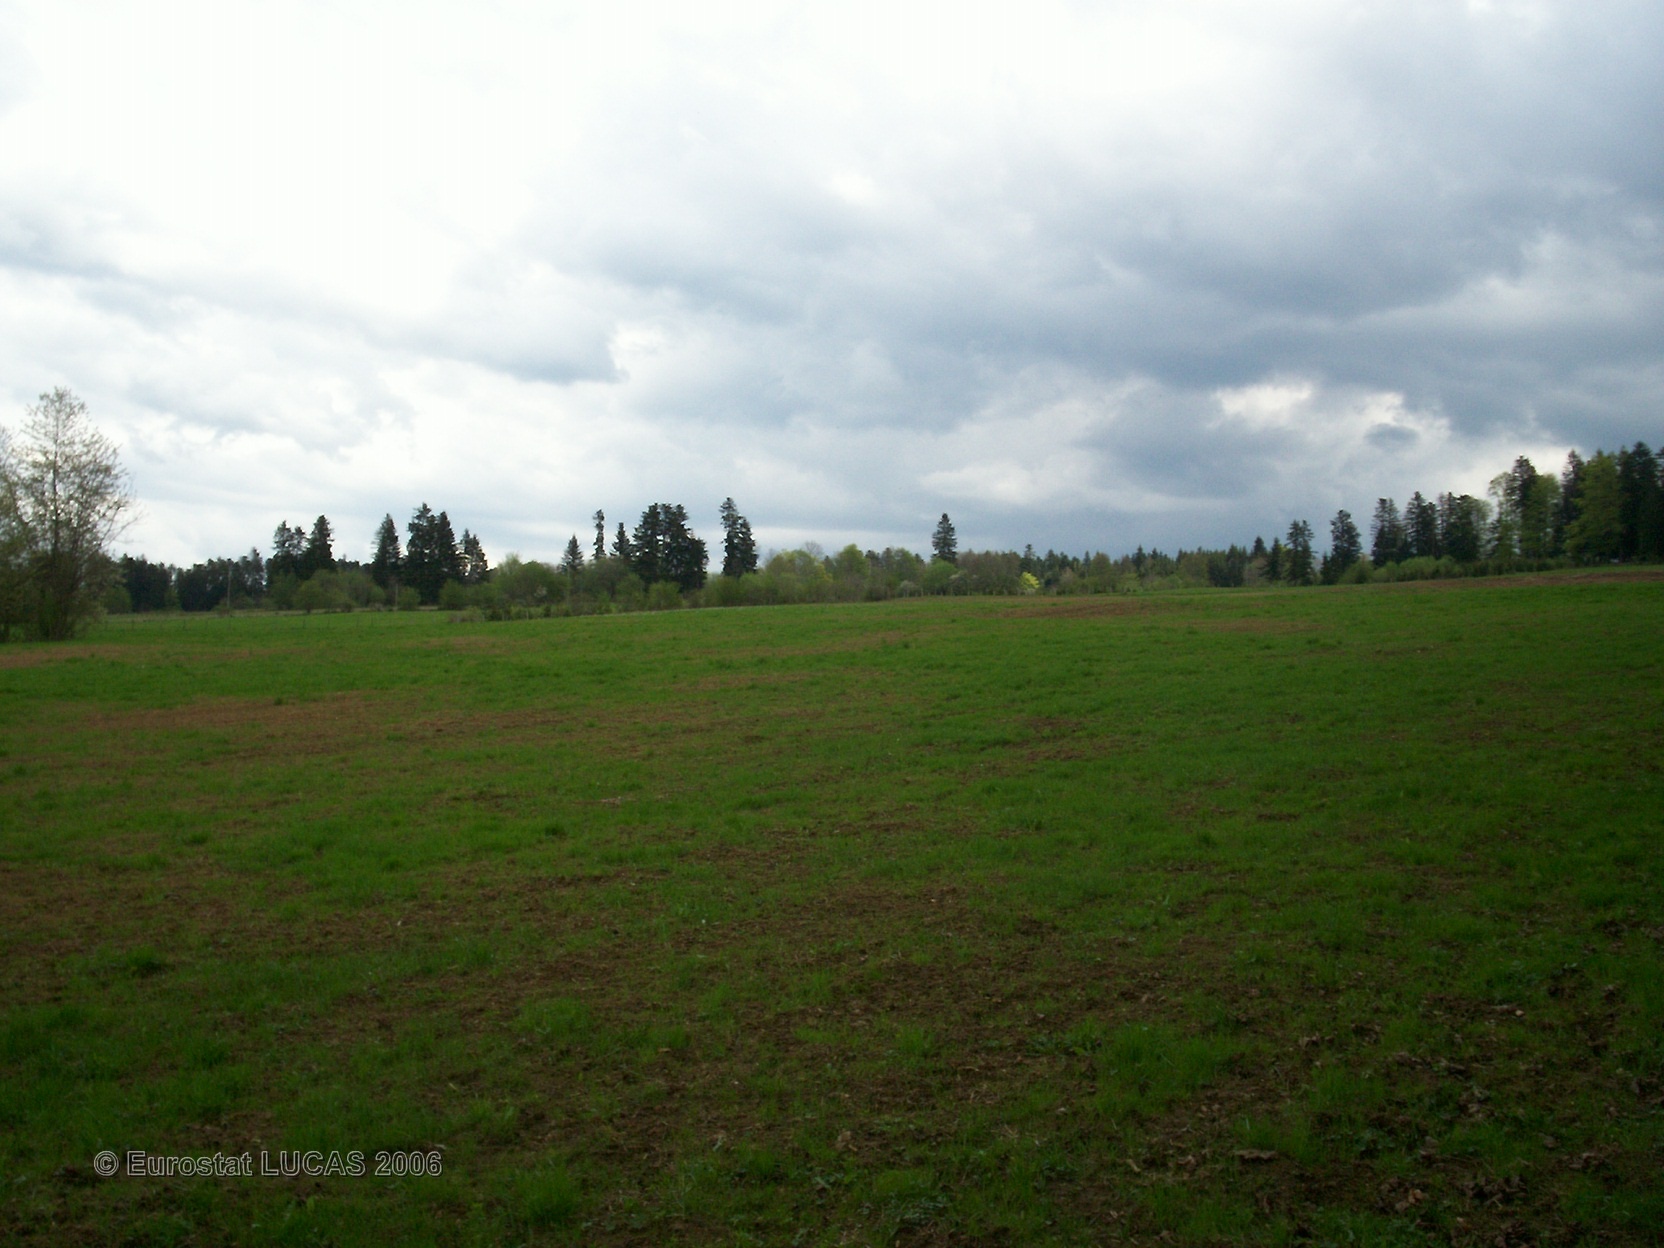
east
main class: Grassland
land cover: Grassland without tree/shrub cover
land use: Agriculture (excluding fallow land and kitchen gardens)
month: May
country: FR
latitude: 47.1455
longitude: 6.6395
